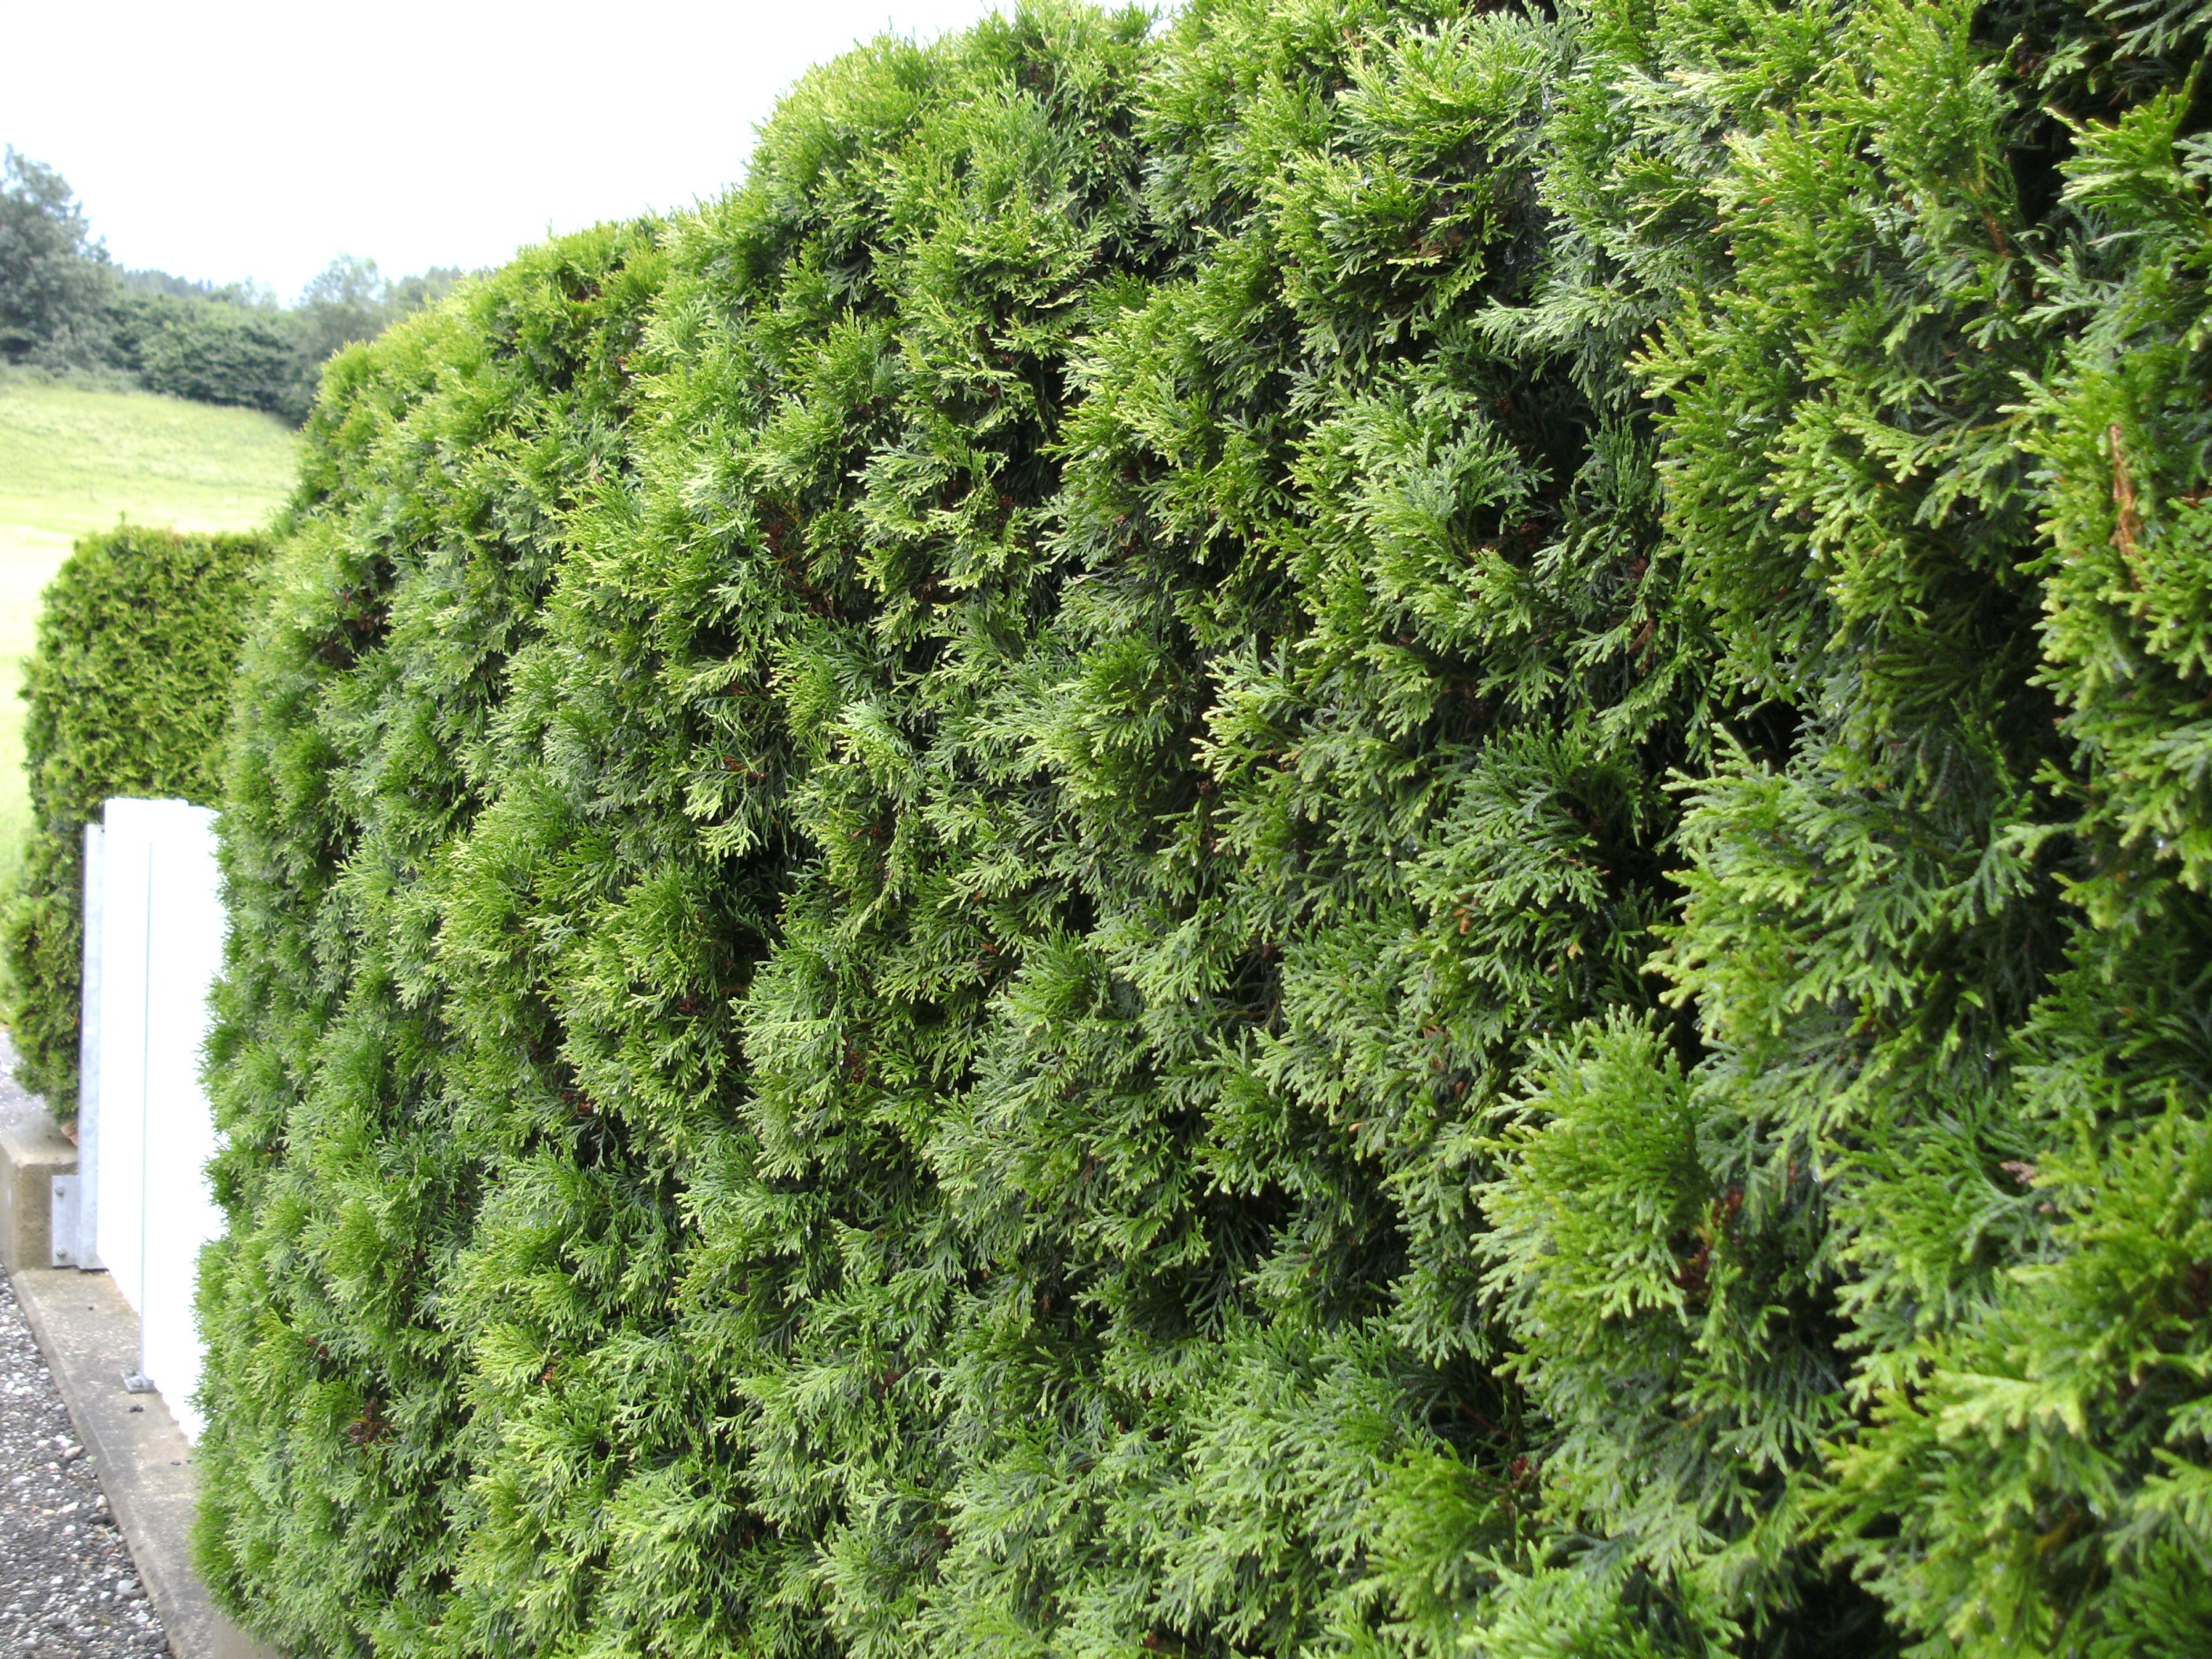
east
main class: Grassland
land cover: Grassland without tree/shrub cover
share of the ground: > 75 %
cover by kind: herbaceous plants 100 %
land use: Residential
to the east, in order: Conifer hedges; Artificial constructions in urban areas; Grassland without tree/shrub cover; Artificial constructions in urban areas; Grassland without tree/shrub cover; Electric lines; Grassland without tree/shrub cover; Fences; Grassland with sparse tree/shrub cover; Shrubland with sparse tree cover; Ditches and canals; Broadleaved woodland; Grassland without tree/shrub cover
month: July
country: AT
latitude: 46.9652
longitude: 14.7956
